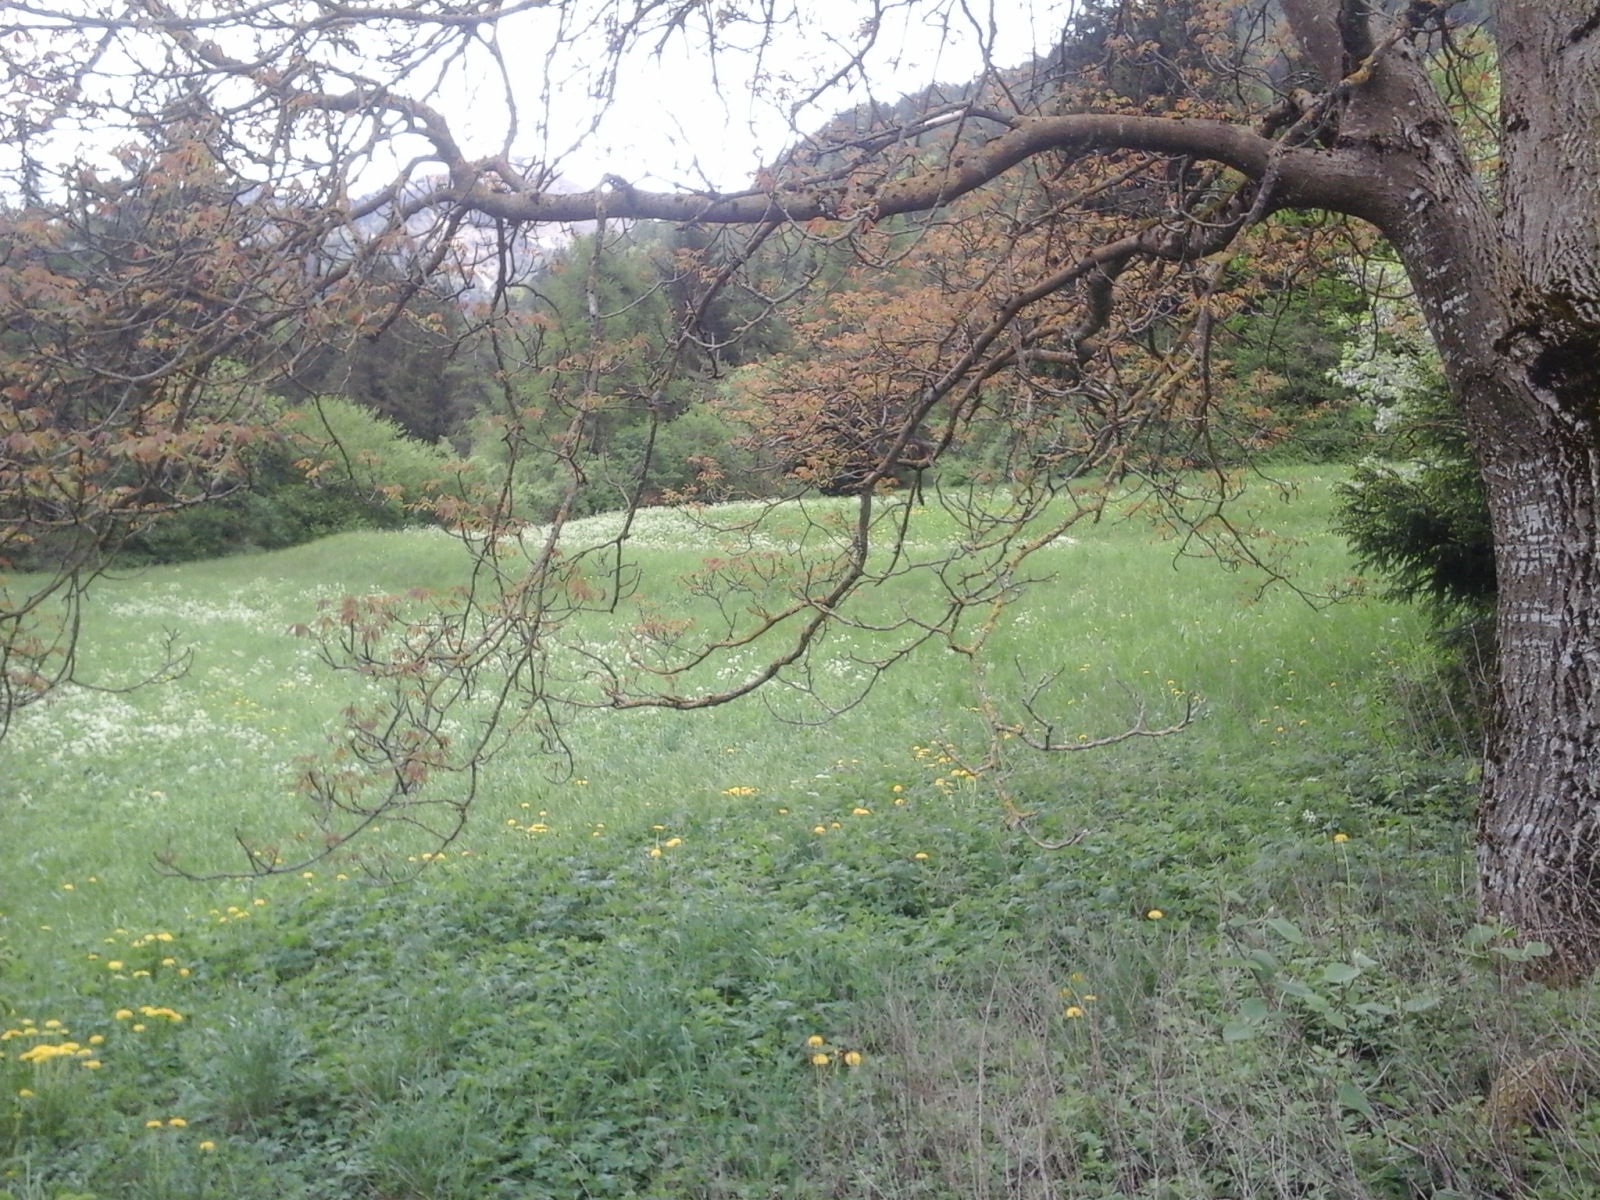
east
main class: Woodland
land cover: Spruce dominated mixed woodland
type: alpine coniferous forest
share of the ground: 25 - 50 %
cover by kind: coniferous forest trees 50 %, herbaceous plants 30 %, broadleaved forest trees 20 %
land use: Forestry
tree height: > 5 m
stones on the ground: > 50 %
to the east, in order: Spruce dominated mixed woodland; Grassland without tree/shrub cover; Electric lines; Grassland without tree/shrub cover; Fences; Grass margins; Paved roads, cycling and walking lanes; Grass margins; Spruce dominated coniferous woodland; Artificial constructions in urban areas; Grass margins; Spruce dominated coniferous woodland; Fences; Tracks; Grassland without tree/shrub cover; Managed hedges; Tracks; Fences; Other mixed woodland; Spruce dominated coniferous woodland
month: May
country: IT
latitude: 45.9887
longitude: 10.6832
